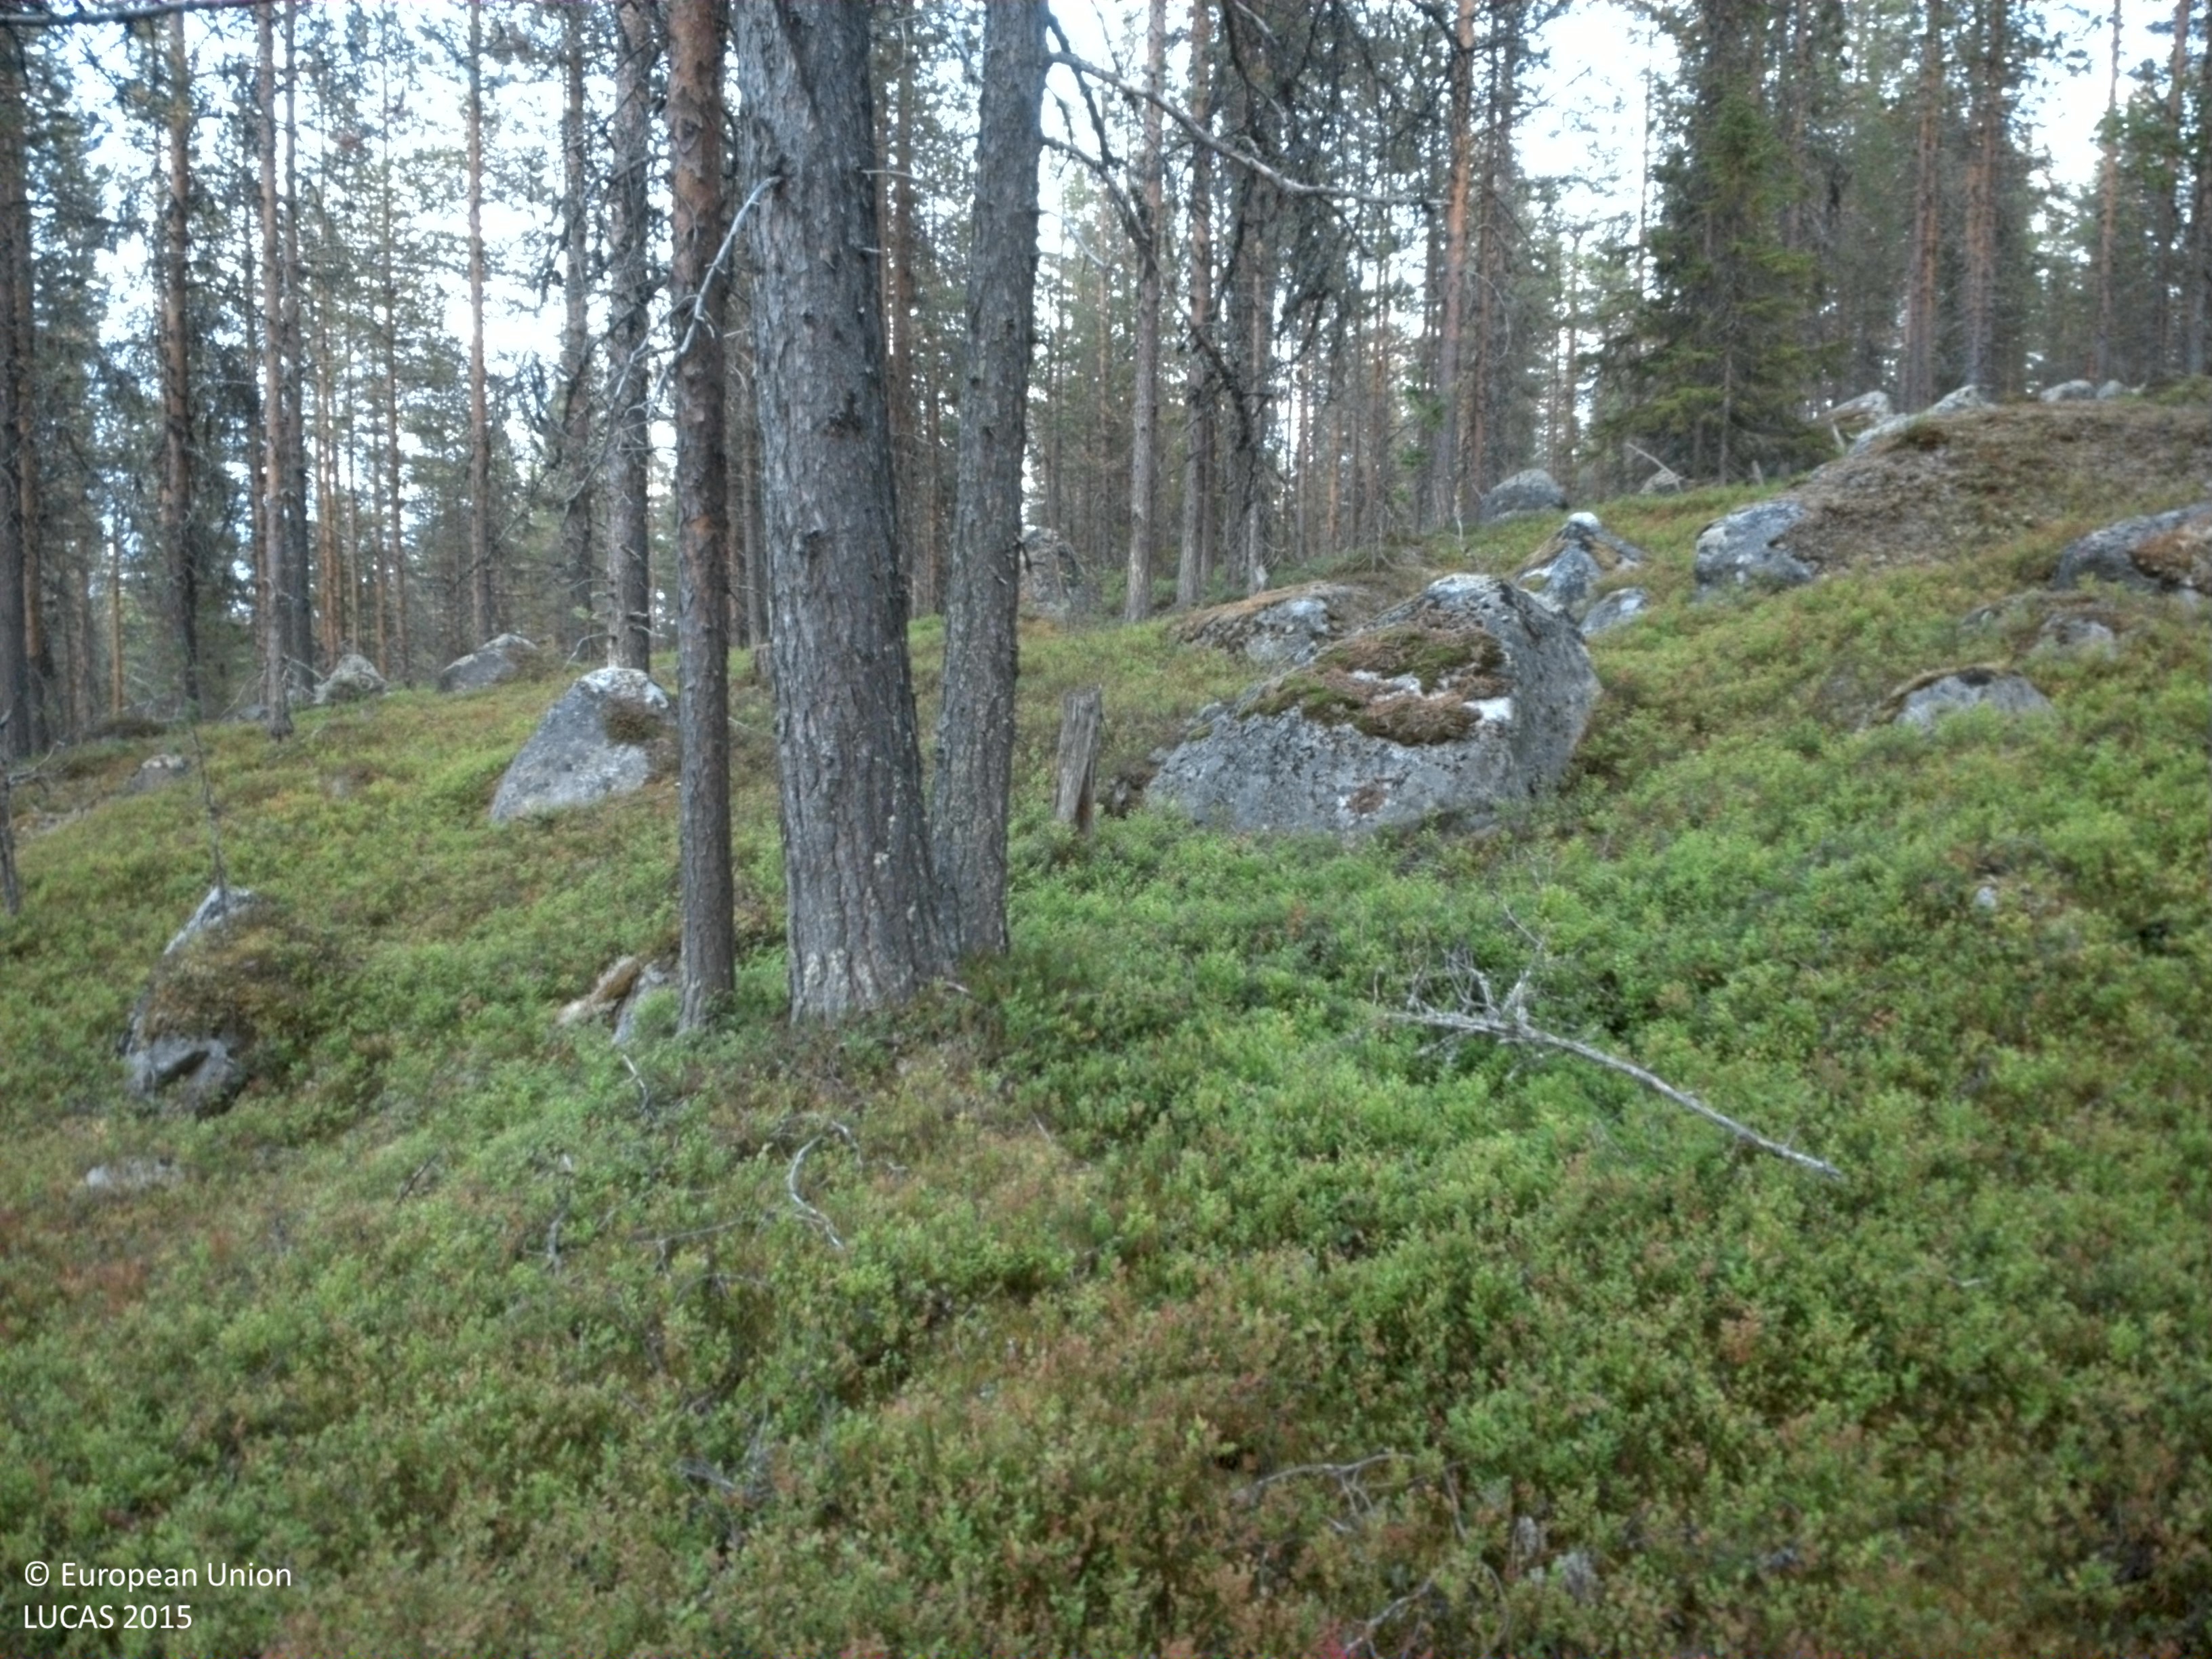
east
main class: Woodland
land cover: Pine dominated coniferous woodland
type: boreal forest
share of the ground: 10 - 25 %
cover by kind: shrubs 65 %, coniferous forest trees 20 %, lichens and mosses 10 %, consolidated bare surface 5 %
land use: Forestry
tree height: > 5 m
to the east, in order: Pine dominated coniferous woodland
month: September
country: SE
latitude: 65.1613
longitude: 17.5791
